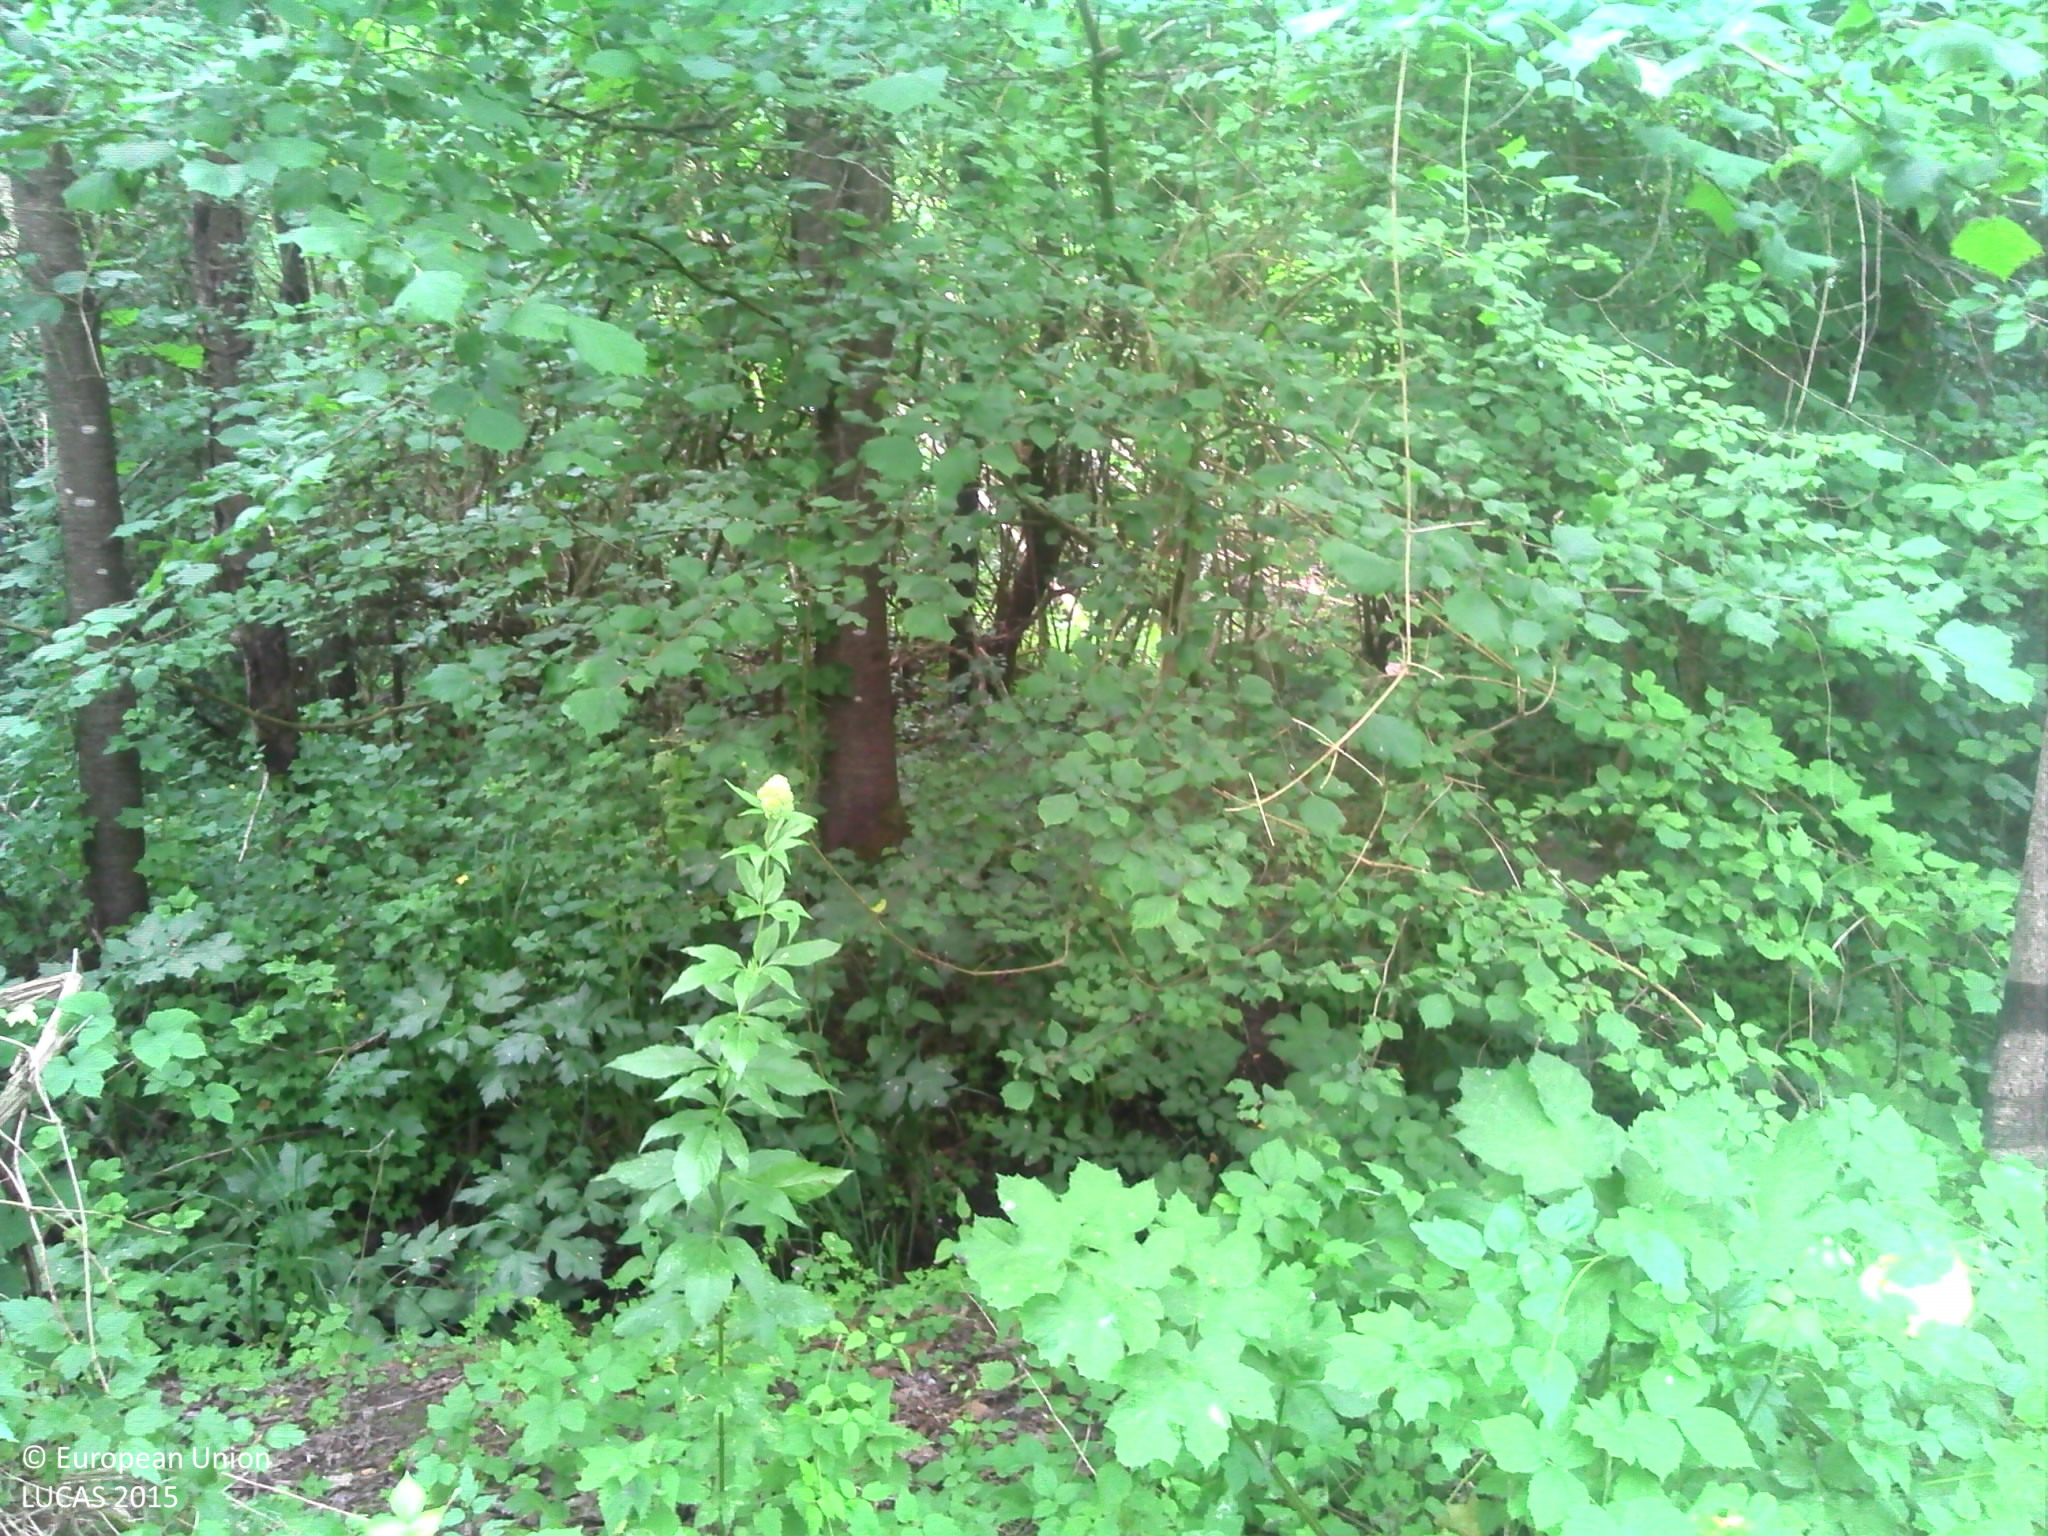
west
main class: Woodland
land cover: Broadleaved woodland
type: floodplain forest
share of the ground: > 75 %
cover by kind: broadleaved forest trees 85 %, herbaceous plants 15 %
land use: Forestry
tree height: > 5 m
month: July
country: FR
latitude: 49.1936
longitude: 3.3095
